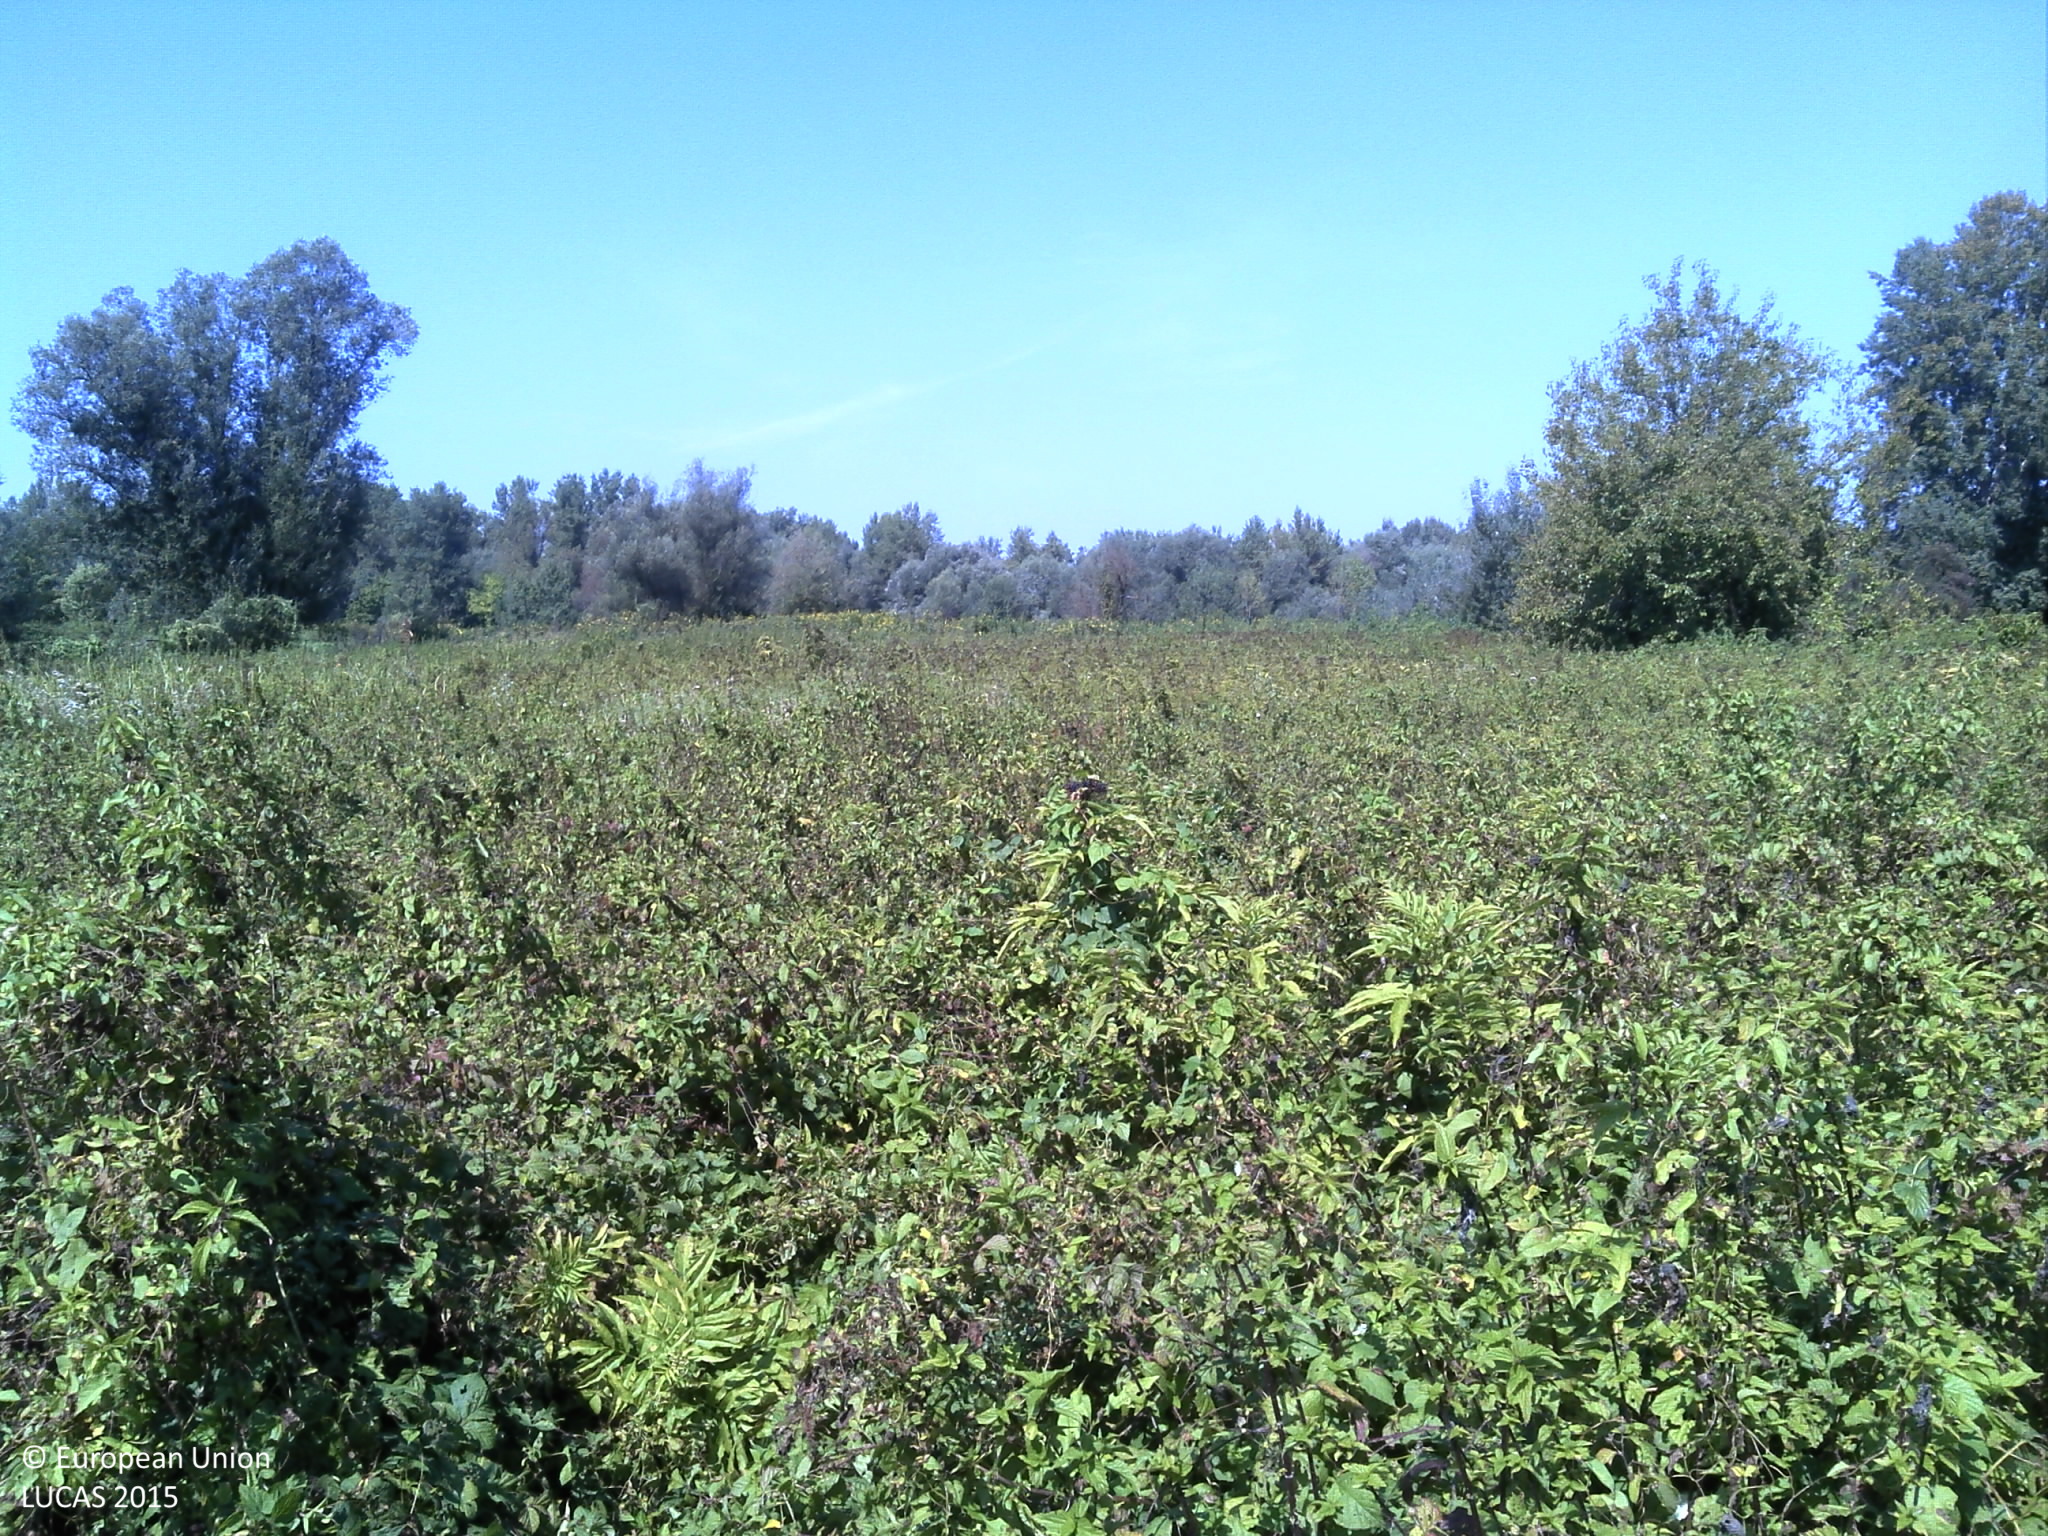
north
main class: Grassland
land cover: Spontaneously vegetated surfaces
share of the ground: > 75 %
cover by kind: herbaceous plants 100 %
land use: Semi-natural and natural areas not in use
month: September
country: HR
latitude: 45.5637
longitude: 16.3913
